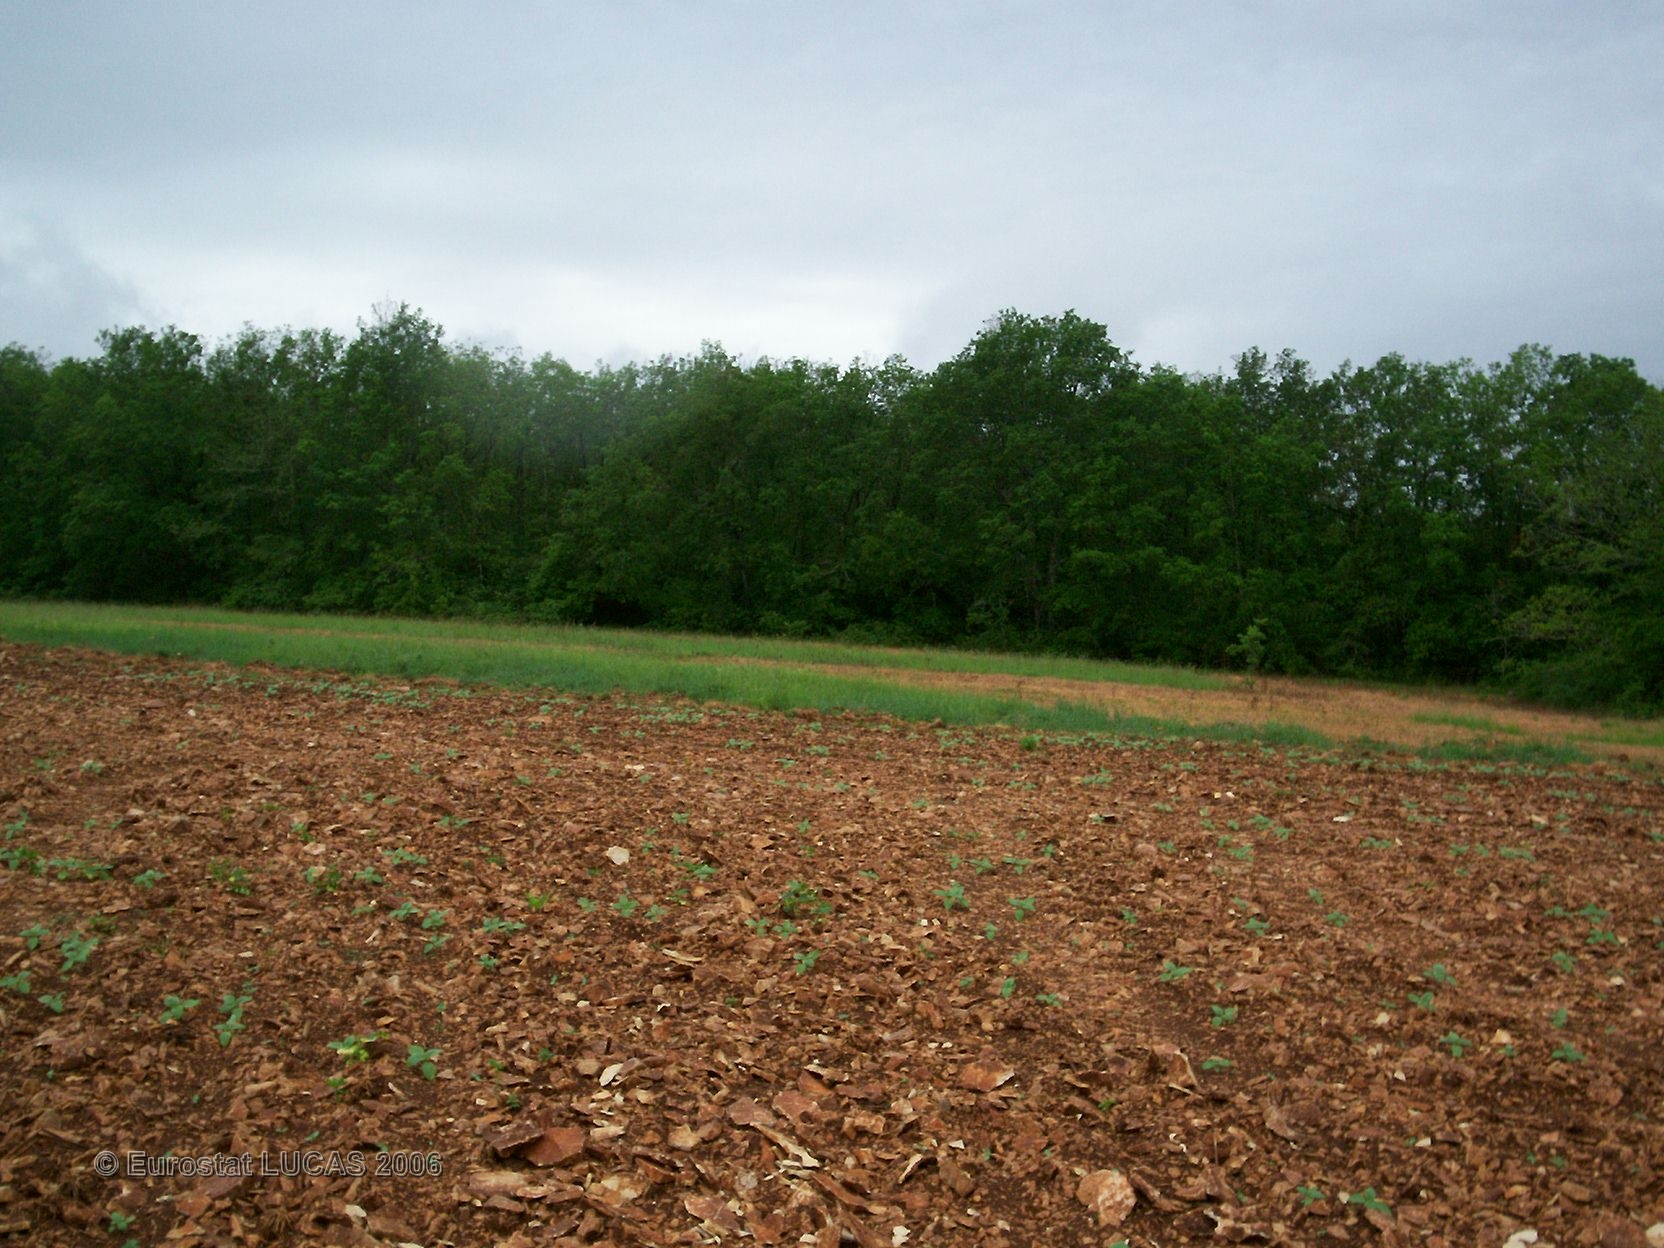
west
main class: Cropland
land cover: Sunflower
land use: Agriculture (excluding fallow land and kitchen gardens)
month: May
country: FR
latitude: 45.6558
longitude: 0.5027
